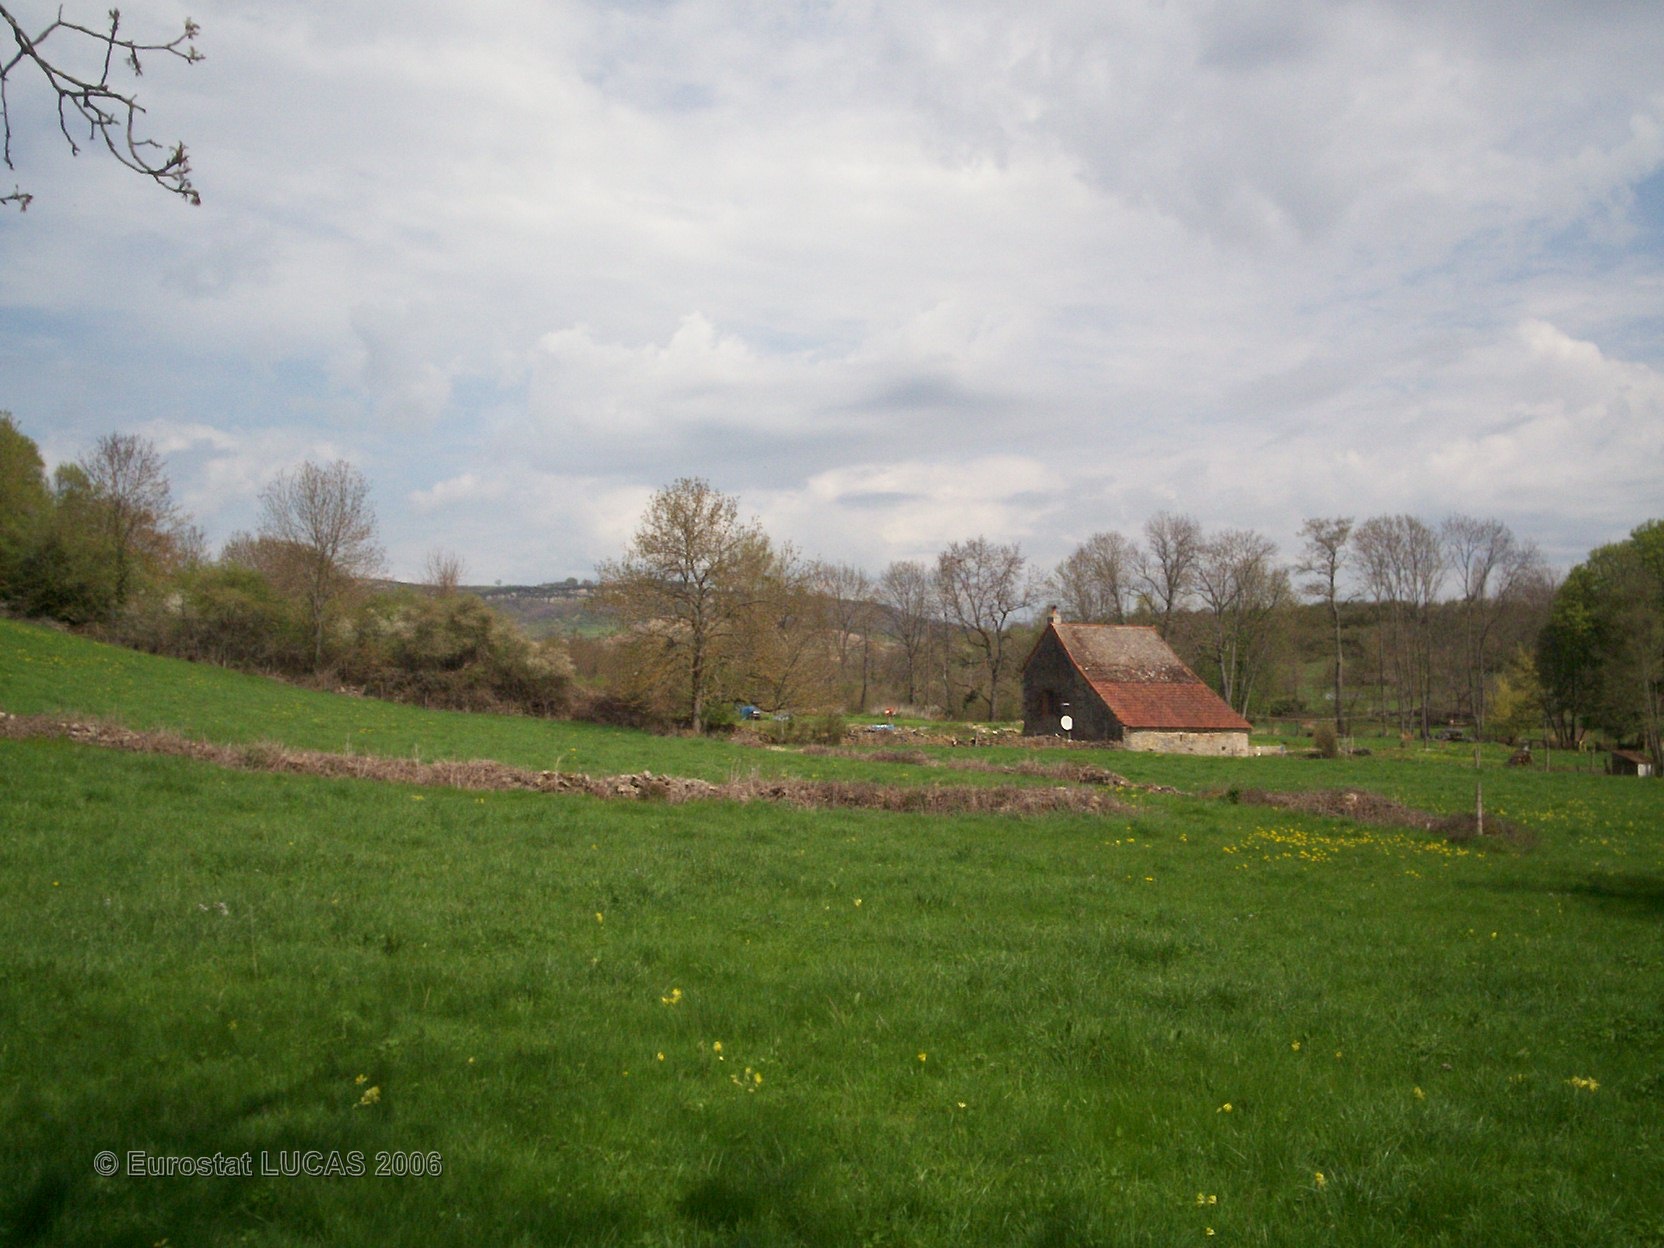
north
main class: Grassland
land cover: Grassland with sparse tree/shrub cover
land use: Agriculture (excluding fallow land and kitchen gardens)
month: April
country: FR
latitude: 46.9381
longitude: 4.6279
